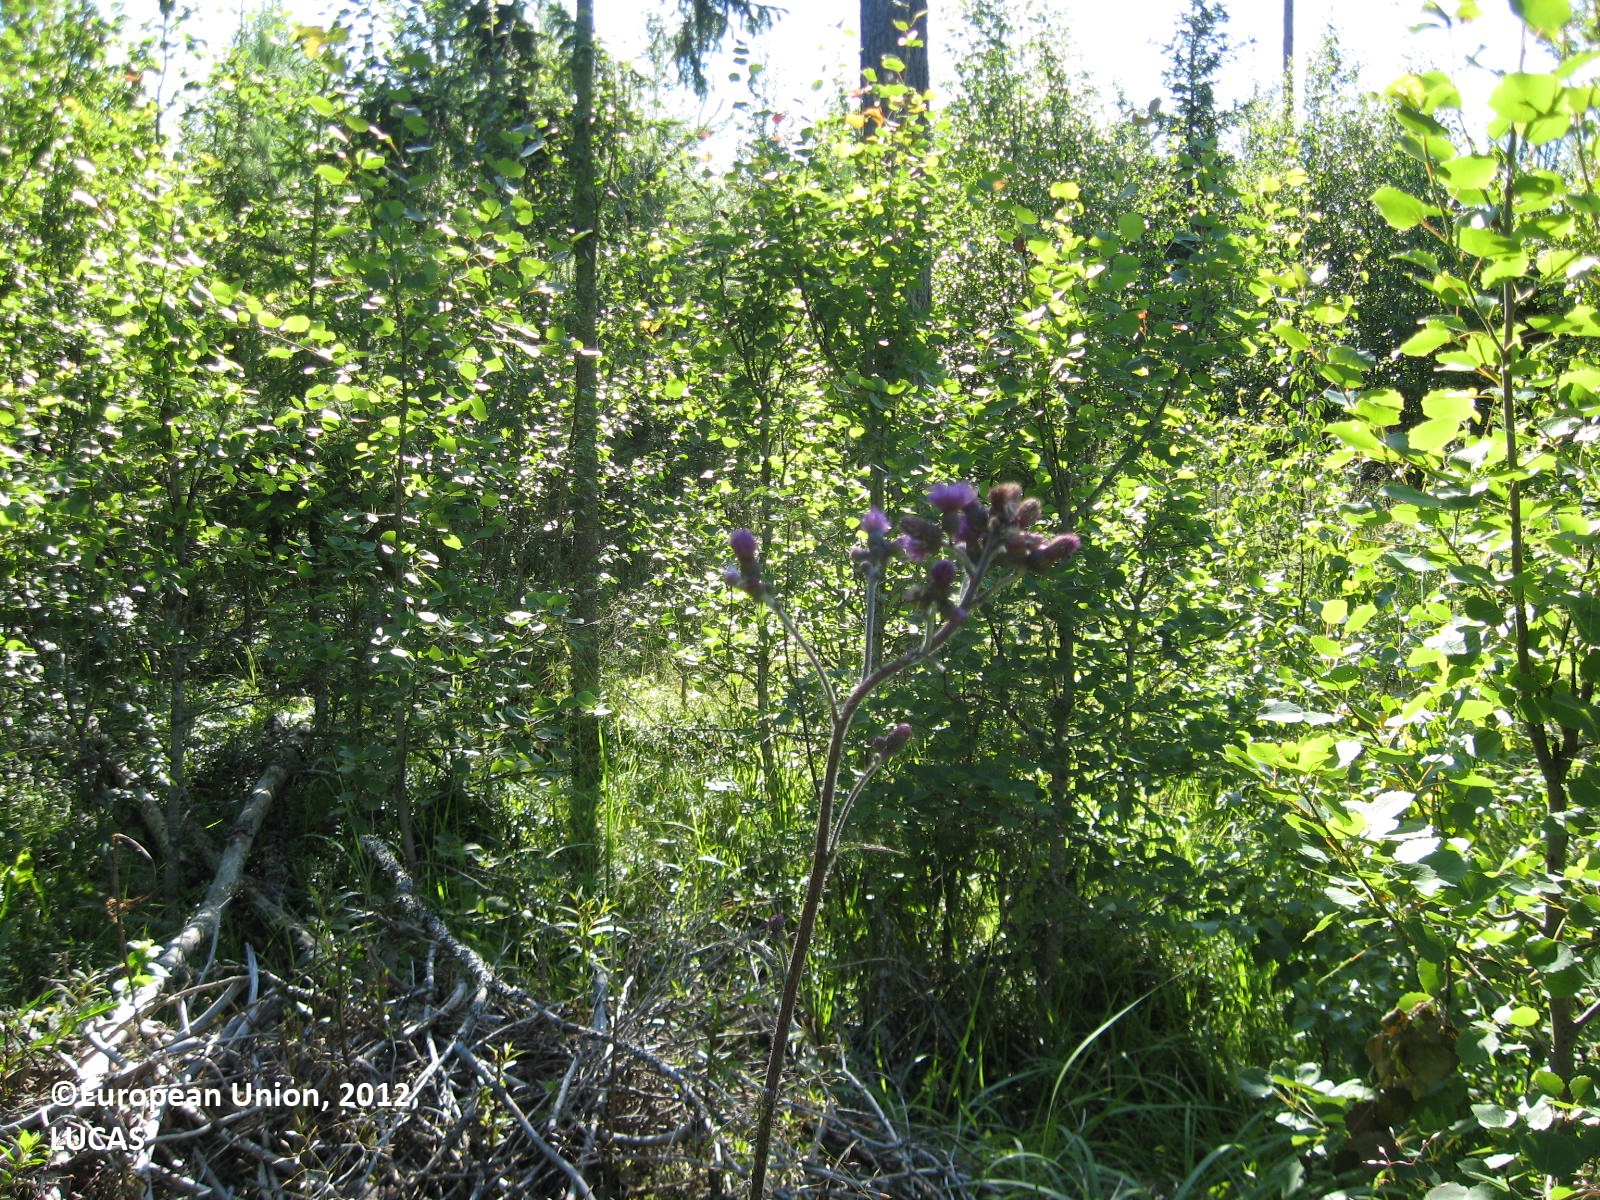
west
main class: Woodland
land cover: Broadleaved woodland
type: boreal forest
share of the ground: > 75 %
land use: Forestry
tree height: > 5 m
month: July
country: FI
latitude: 62.1400
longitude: 21.4199
